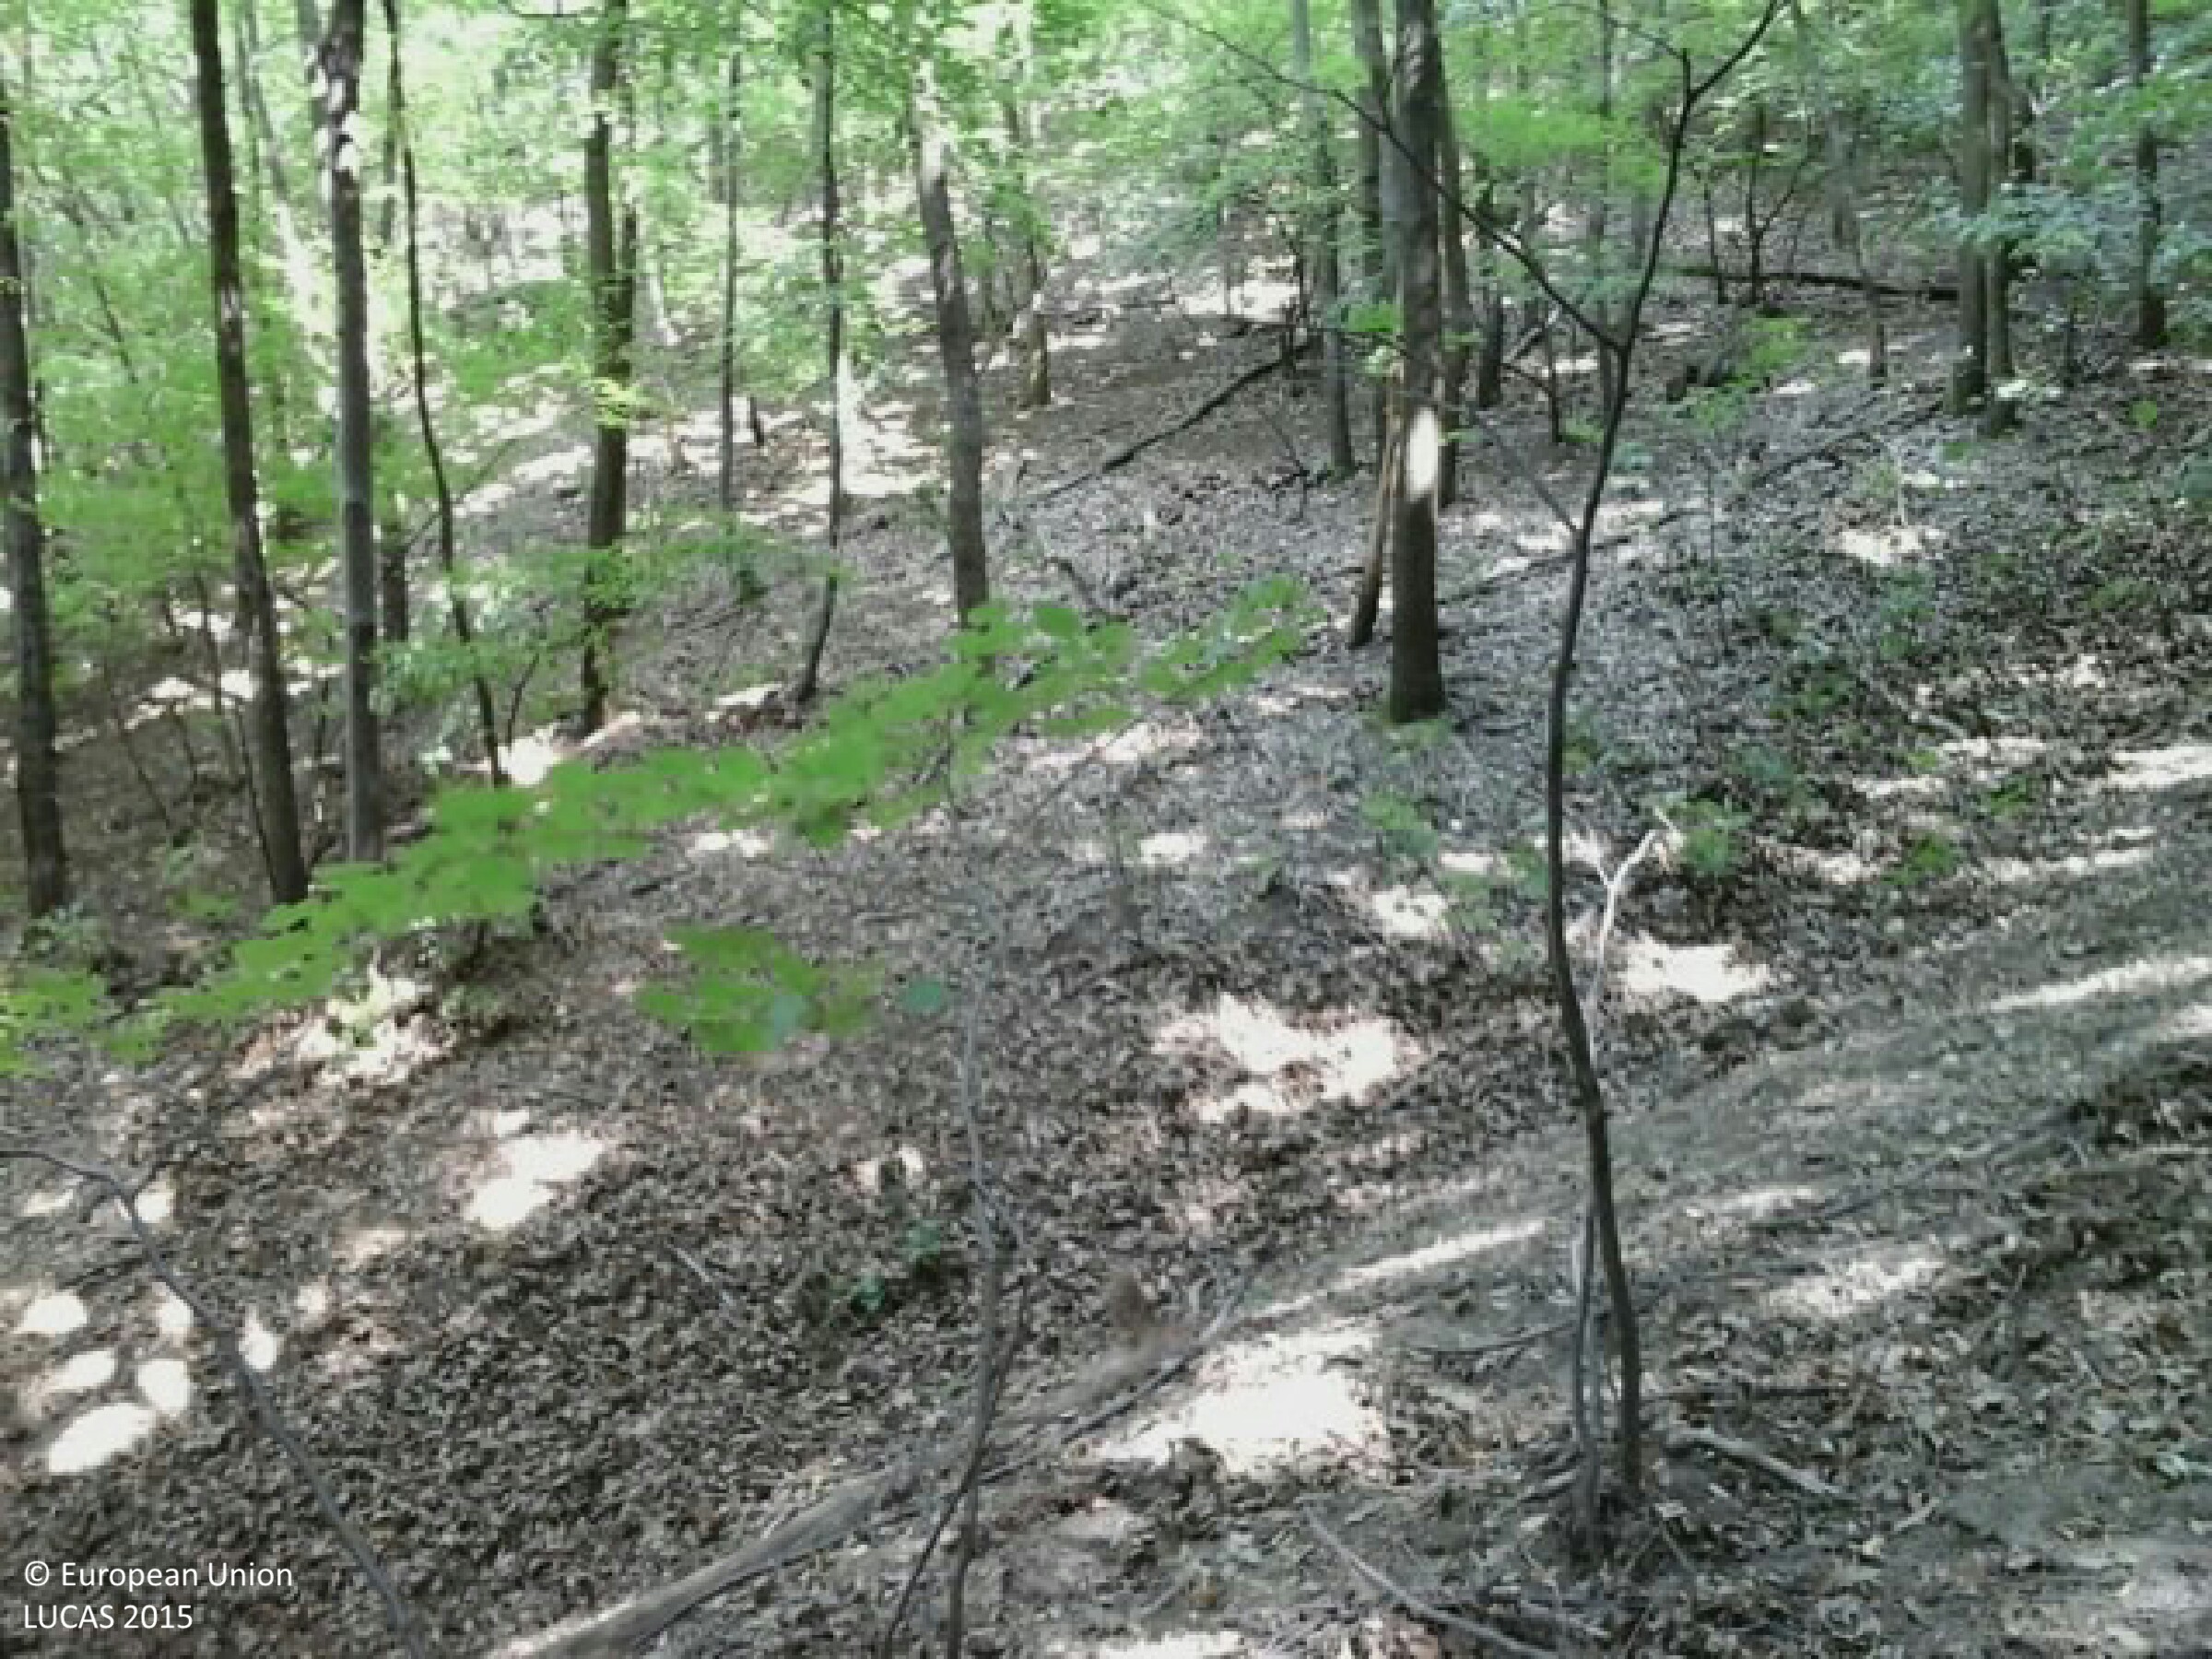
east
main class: Woodland
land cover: Broadleaved woodland
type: beech forest
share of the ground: 50 - 75 %
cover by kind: broadleaved forest trees 100 %
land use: Forestry
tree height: > 5 m
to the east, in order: Broadleaved woodland
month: July
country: HU
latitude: 47.7958
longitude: 19.2723
